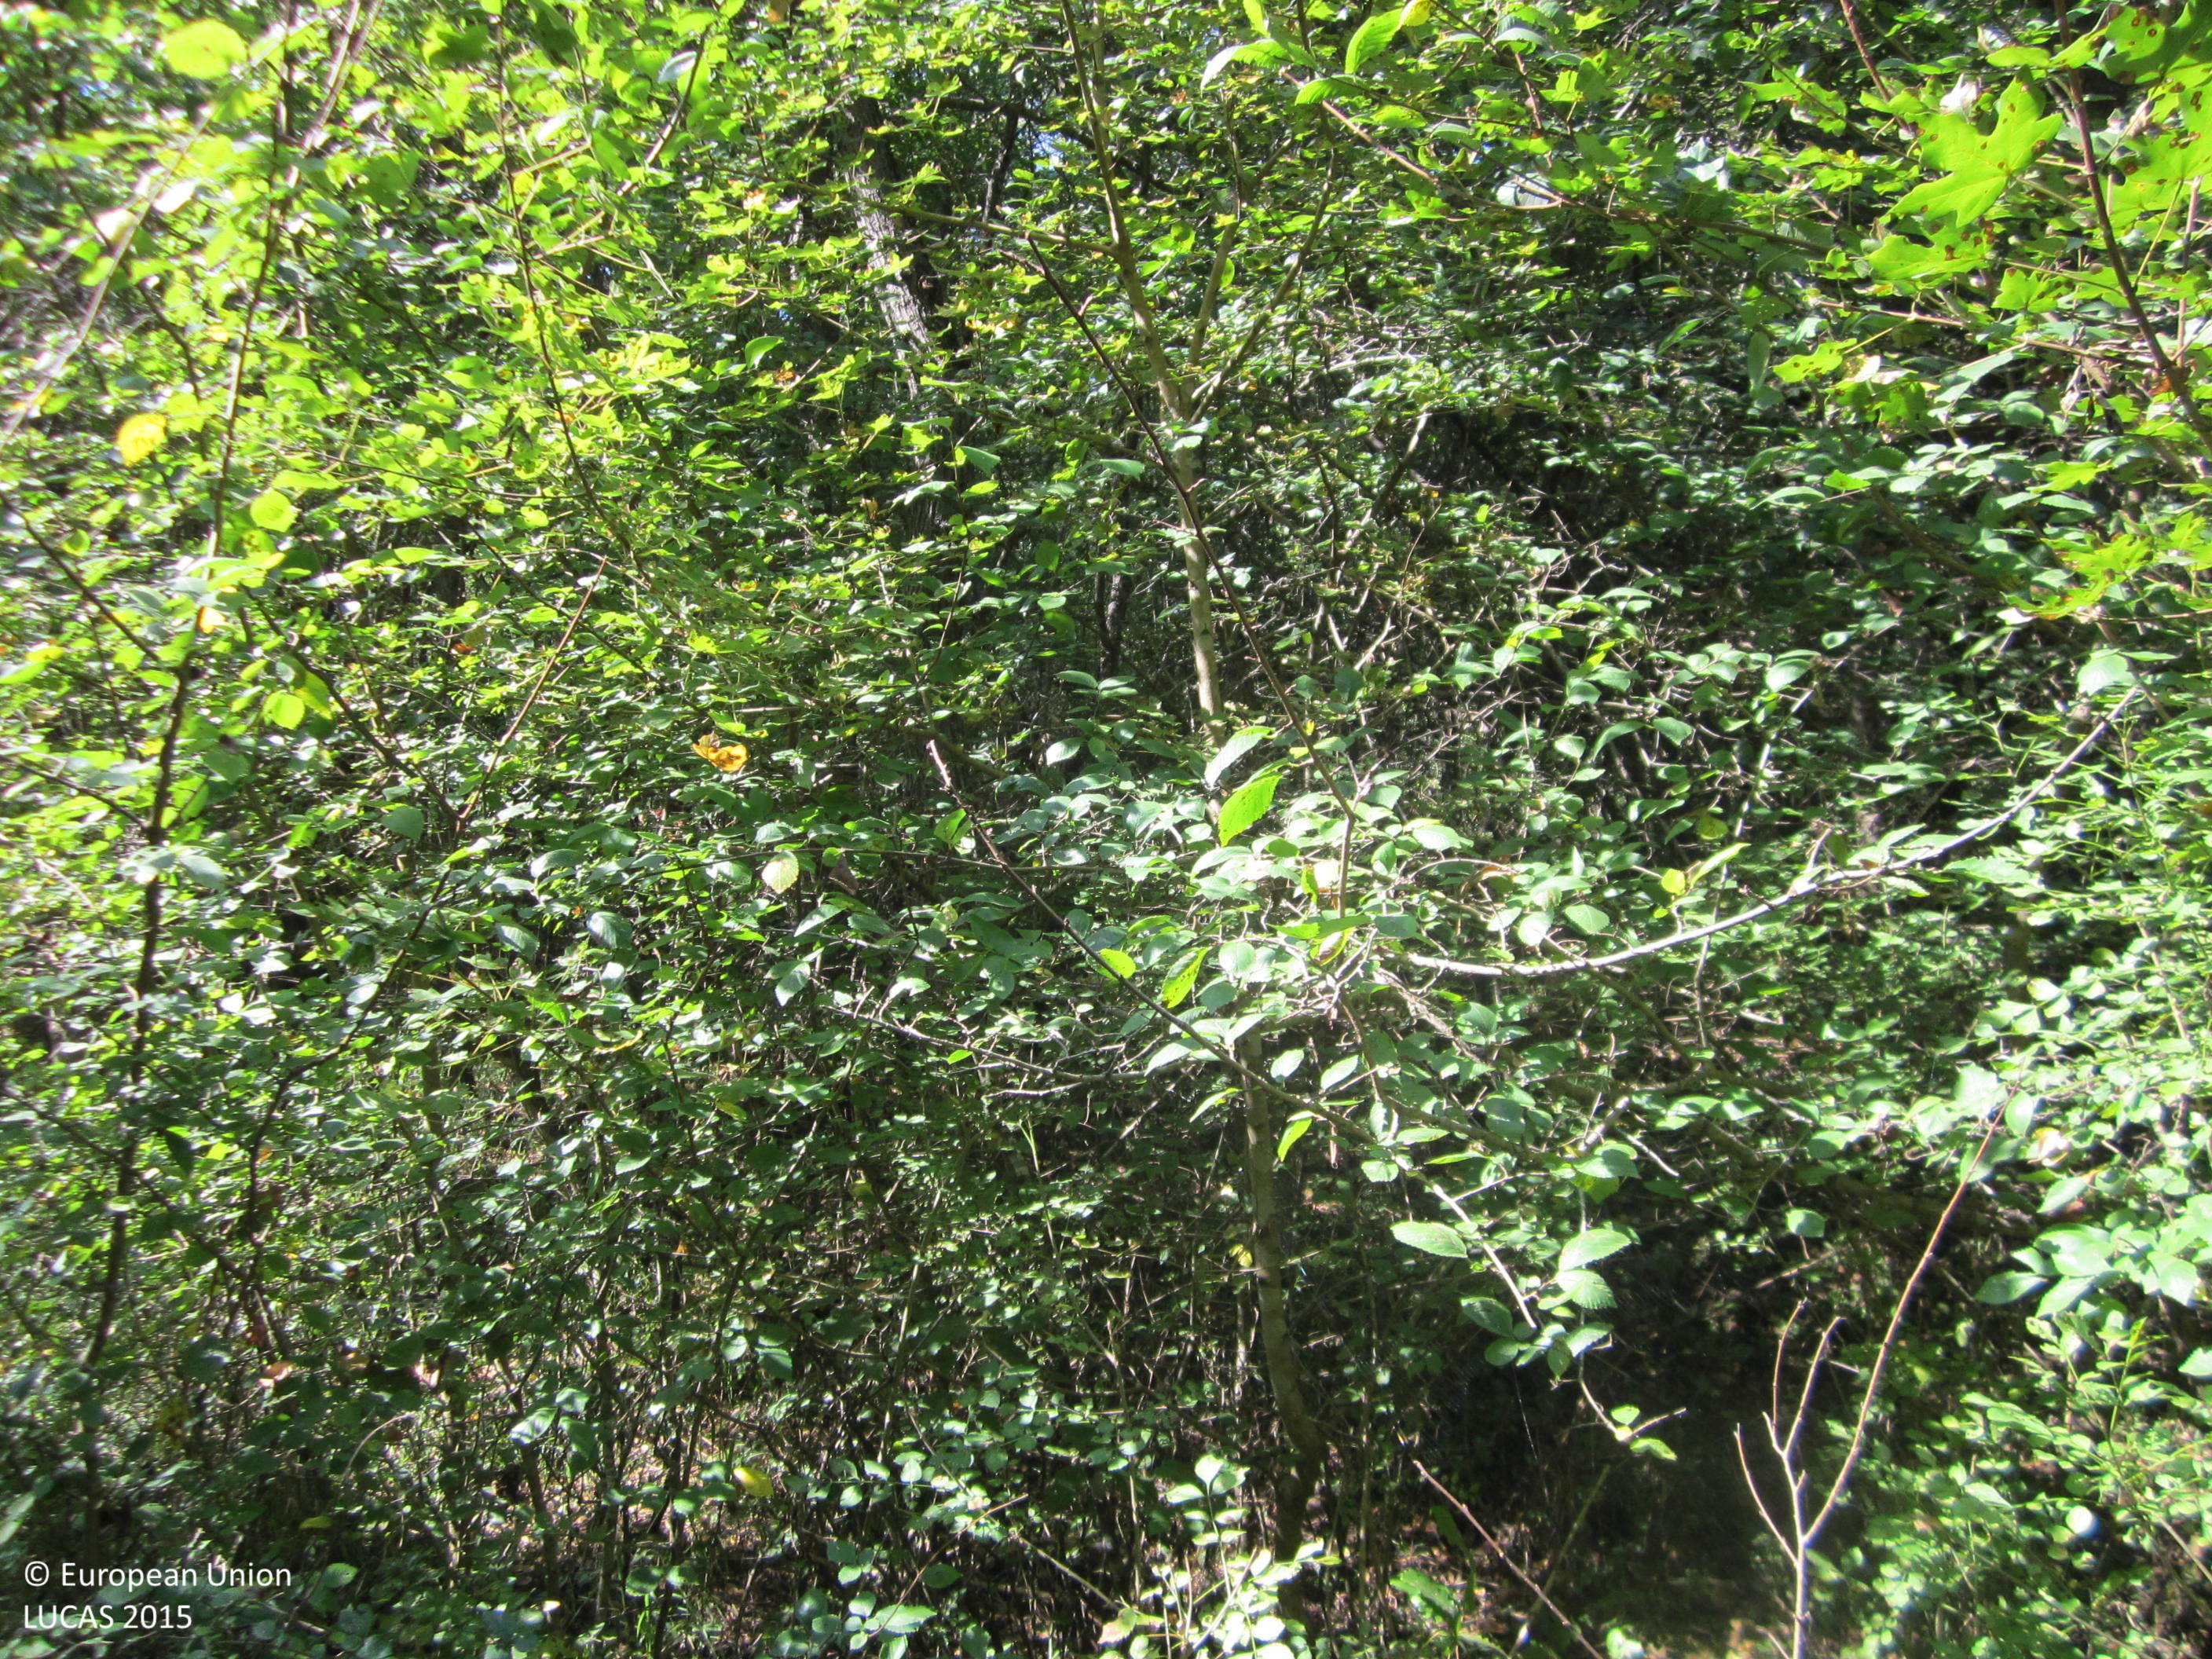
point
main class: Woodland
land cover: Broadleaved woodland
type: mesophytic deciduous forest
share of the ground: > 75 %
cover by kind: broadleaved forest trees 85 %, shrubs 15 %
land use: Forestry
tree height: < 5 m
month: September
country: BG
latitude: 42.2115
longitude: 27.7698
